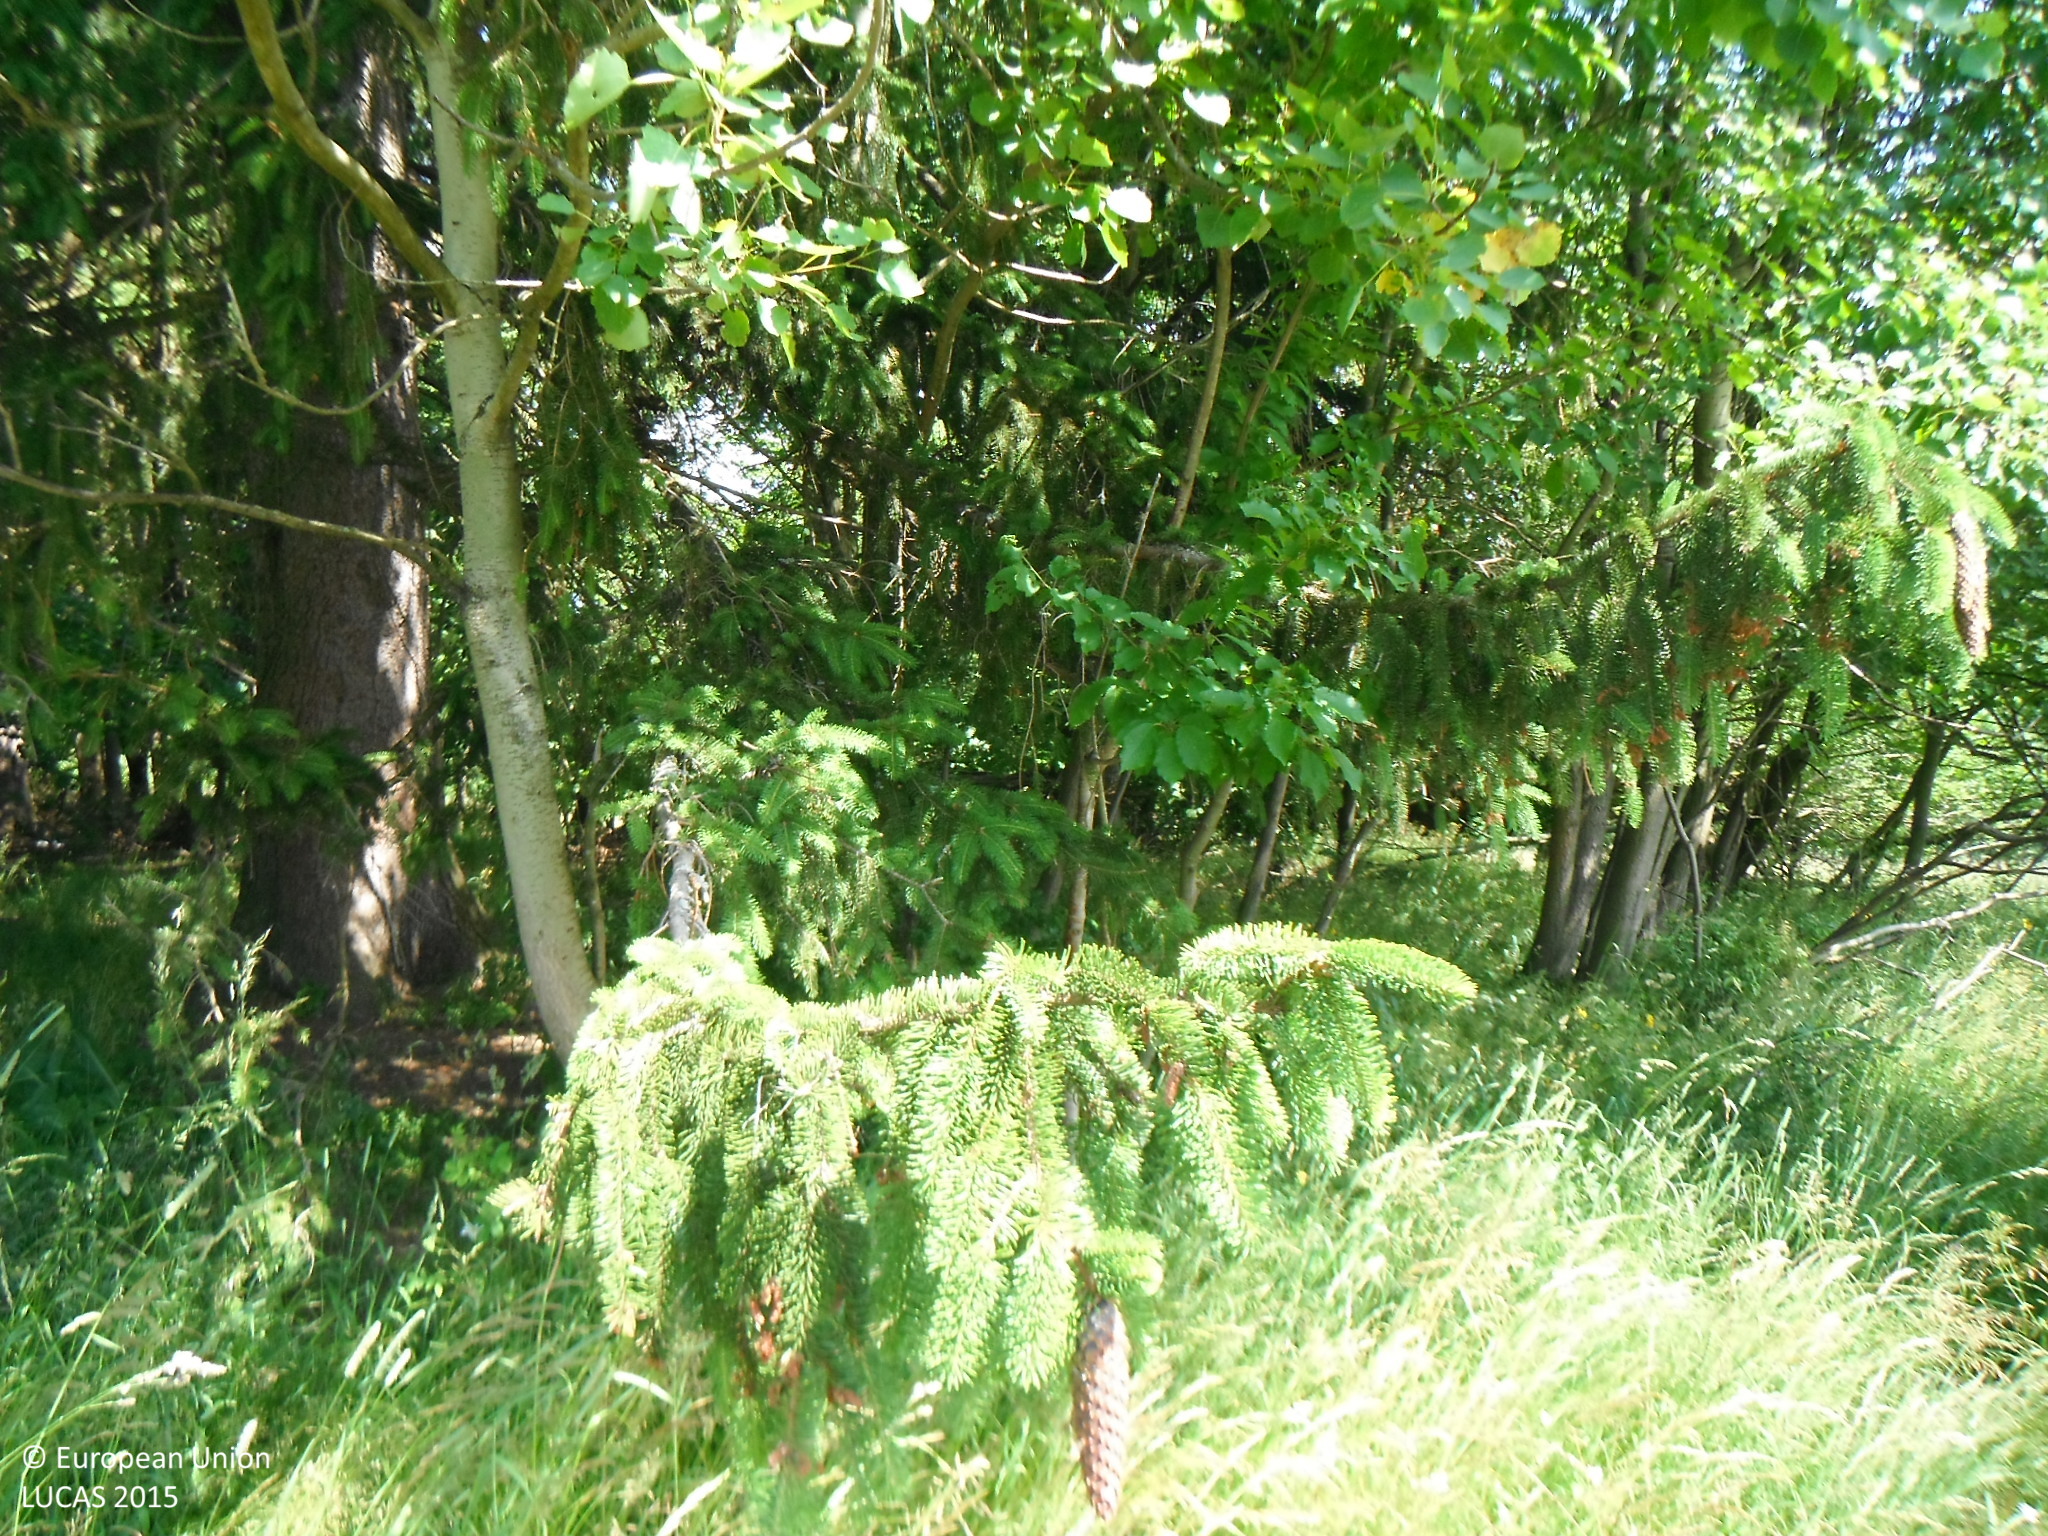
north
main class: Grassland
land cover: Grassland without tree/shrub cover
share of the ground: > 75 %
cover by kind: herbaceous plants 95 %, shrubs 5 %
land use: Agriculture (excluding fallow land and kitchen gardens)
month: July
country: SK
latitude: 49.3412
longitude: 18.5103
